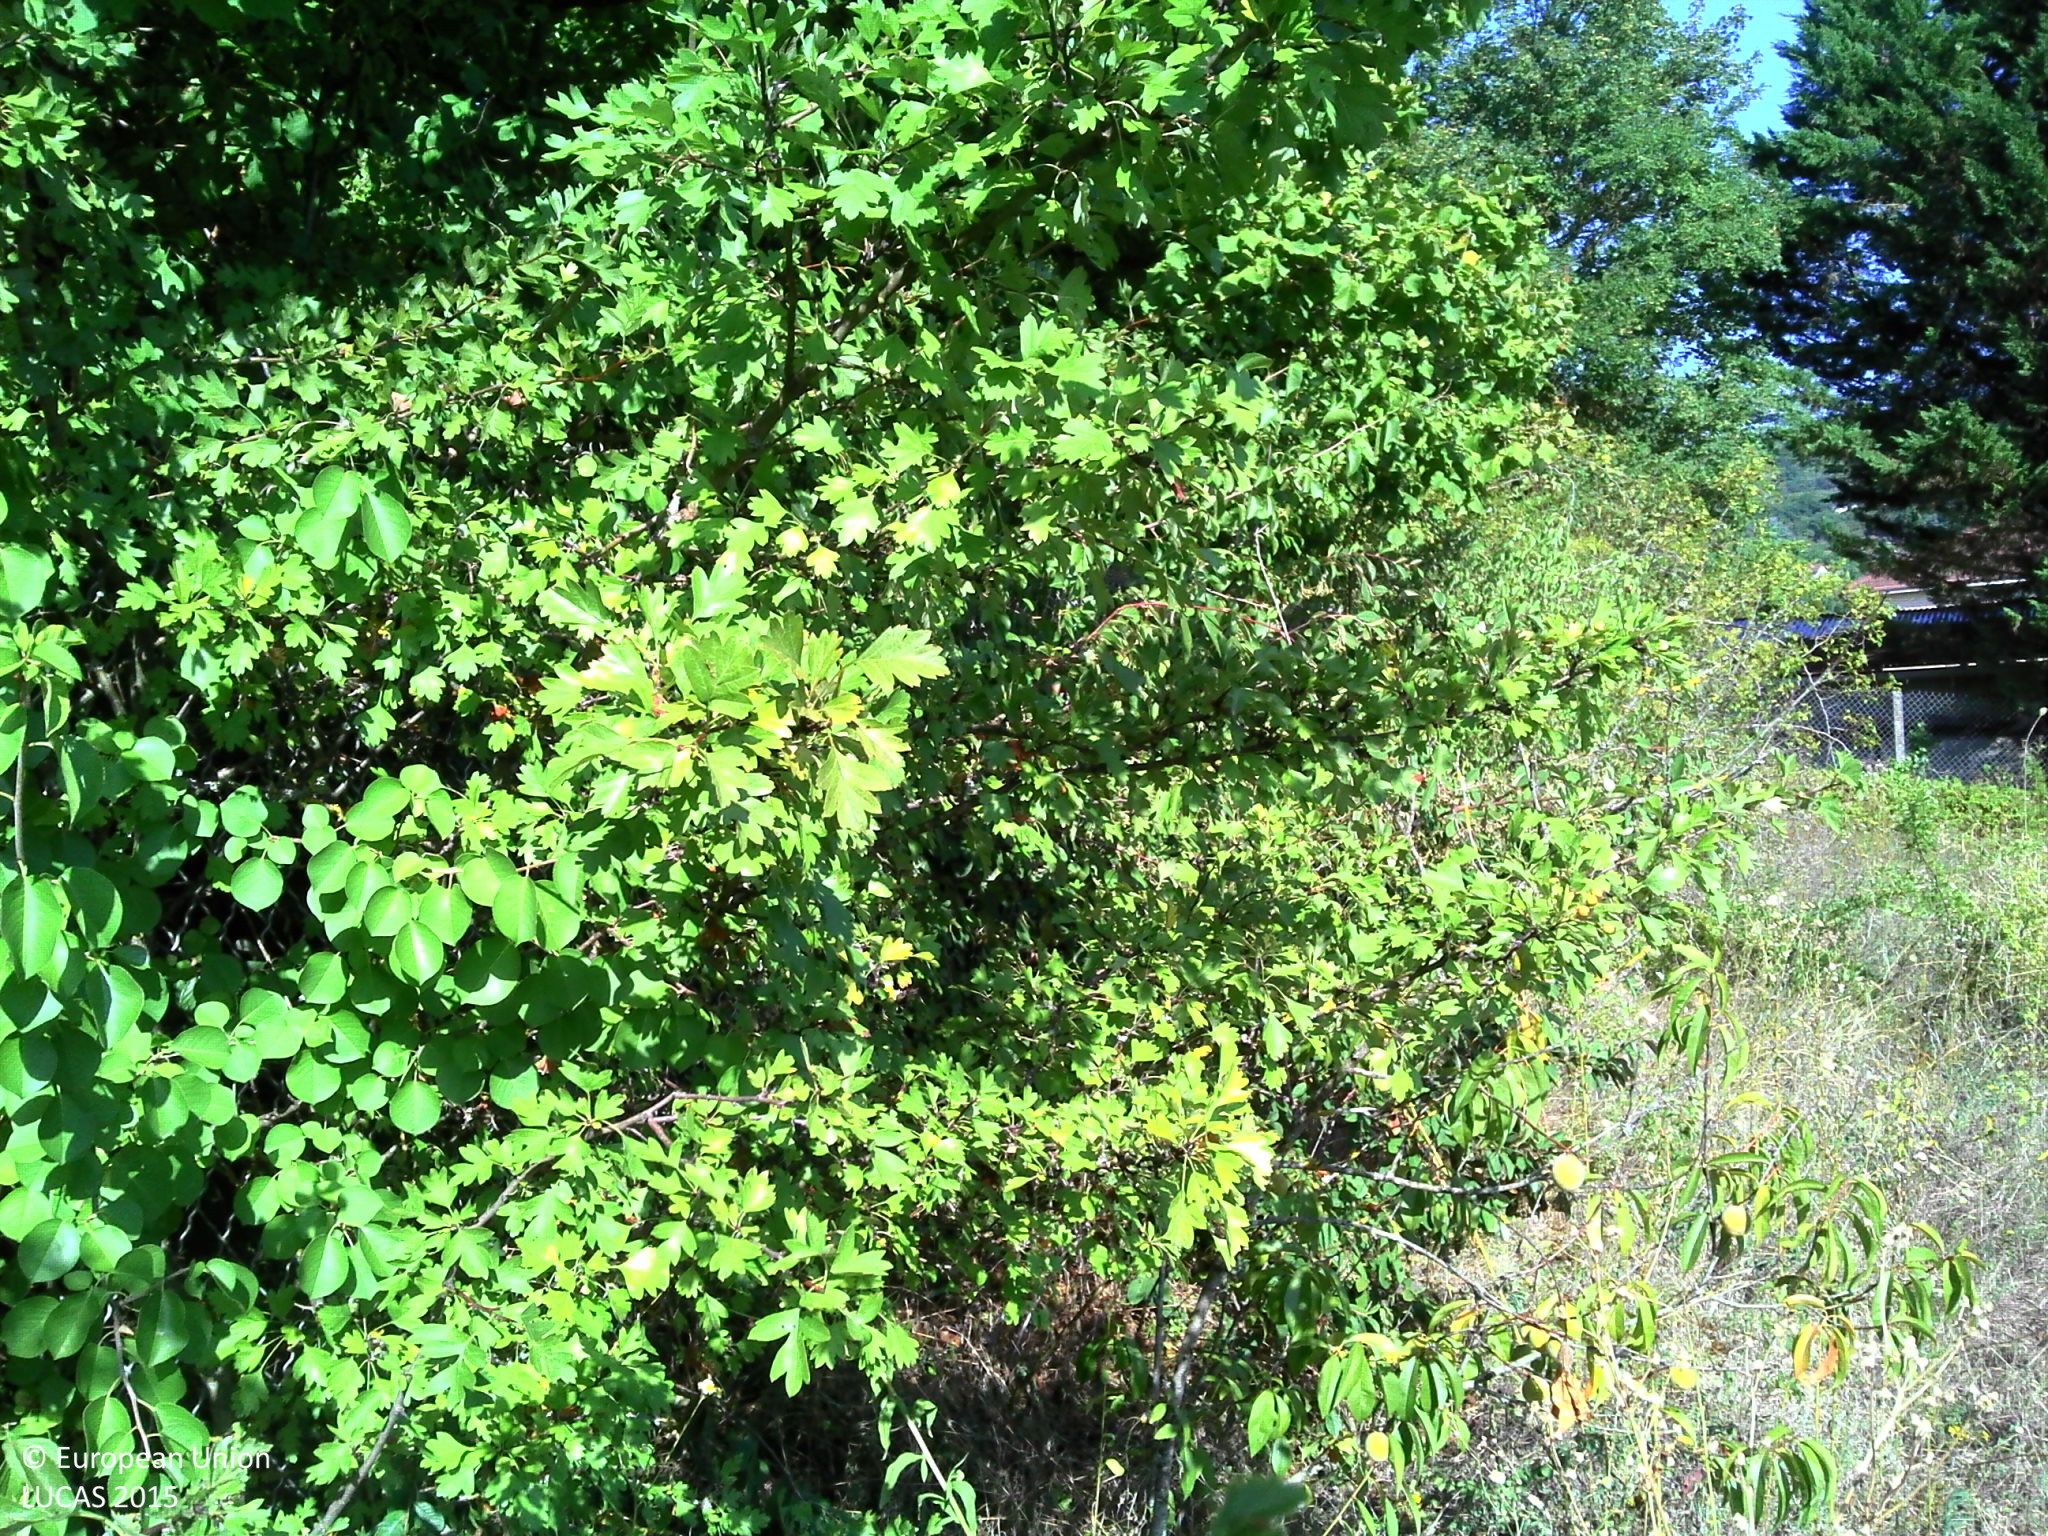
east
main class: Woodland
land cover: Broadleaved woodland
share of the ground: > 75 %
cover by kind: broadleaved forest trees 95 %, coniferous forest trees 5 %
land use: Residential
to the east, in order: Broadleaved woodland; Grassland with sparse tree/shrub cover; Artificial constructions in urban areas
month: August
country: FR
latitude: 45.6824
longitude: 5.1637
